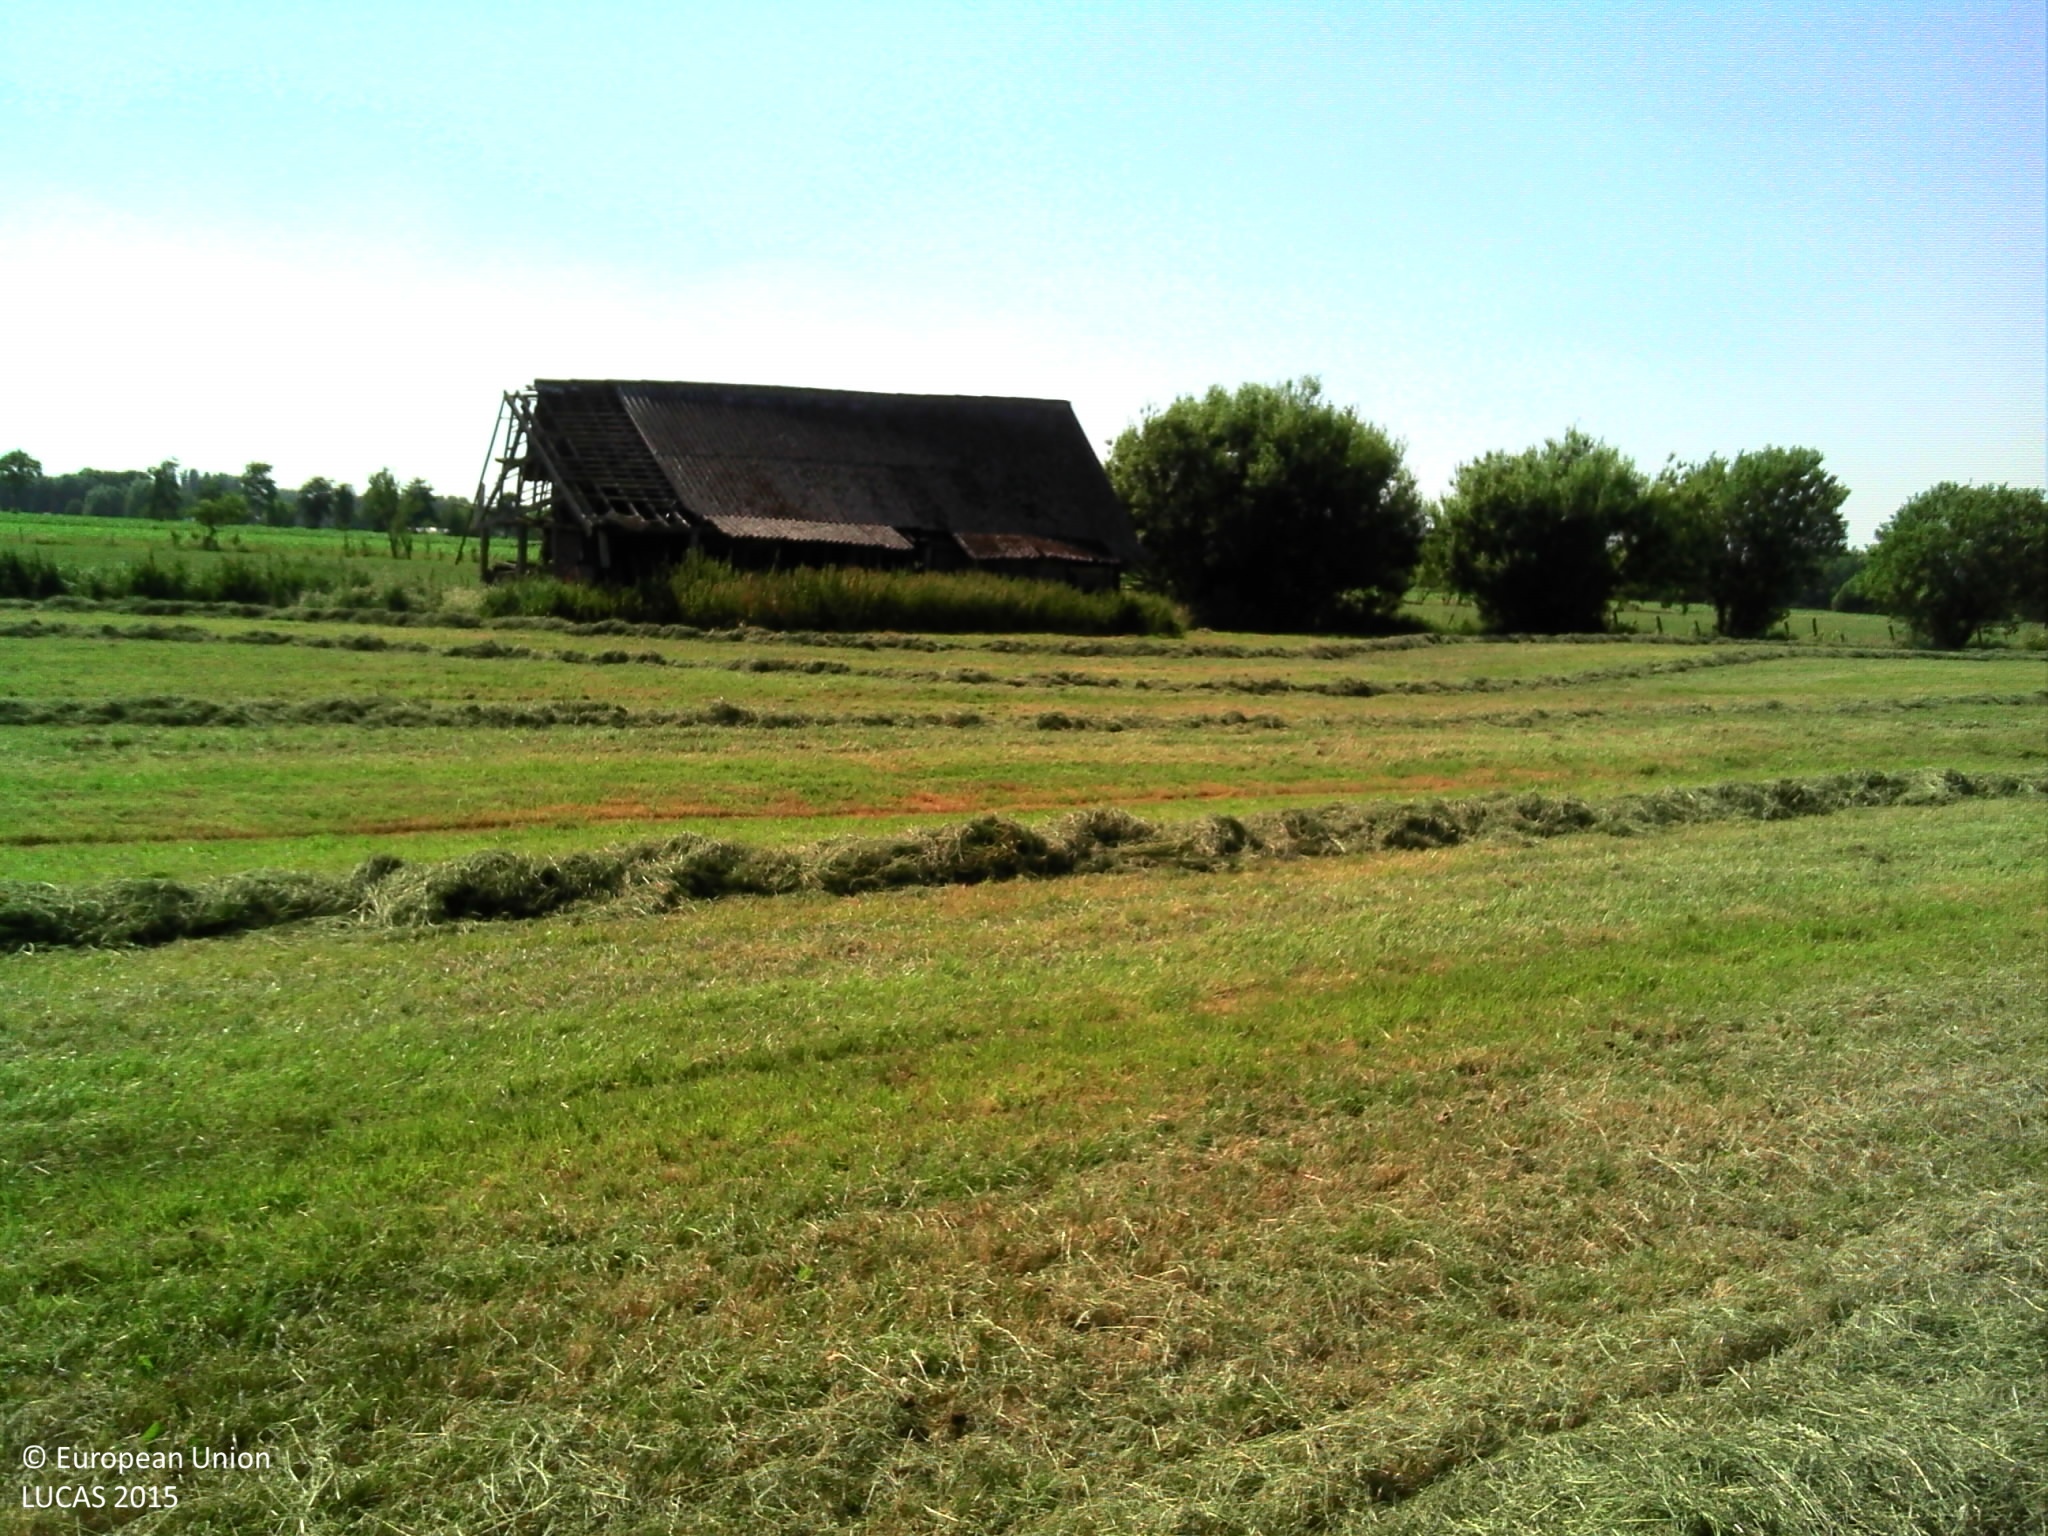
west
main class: Grassland
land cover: Grassland without tree/shrub cover
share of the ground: > 75 %
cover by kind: herbaceous plants 100 %
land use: Agriculture (excluding fallow land and kitchen gardens)
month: June
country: BE
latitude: 51.1262
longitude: 3.6630
